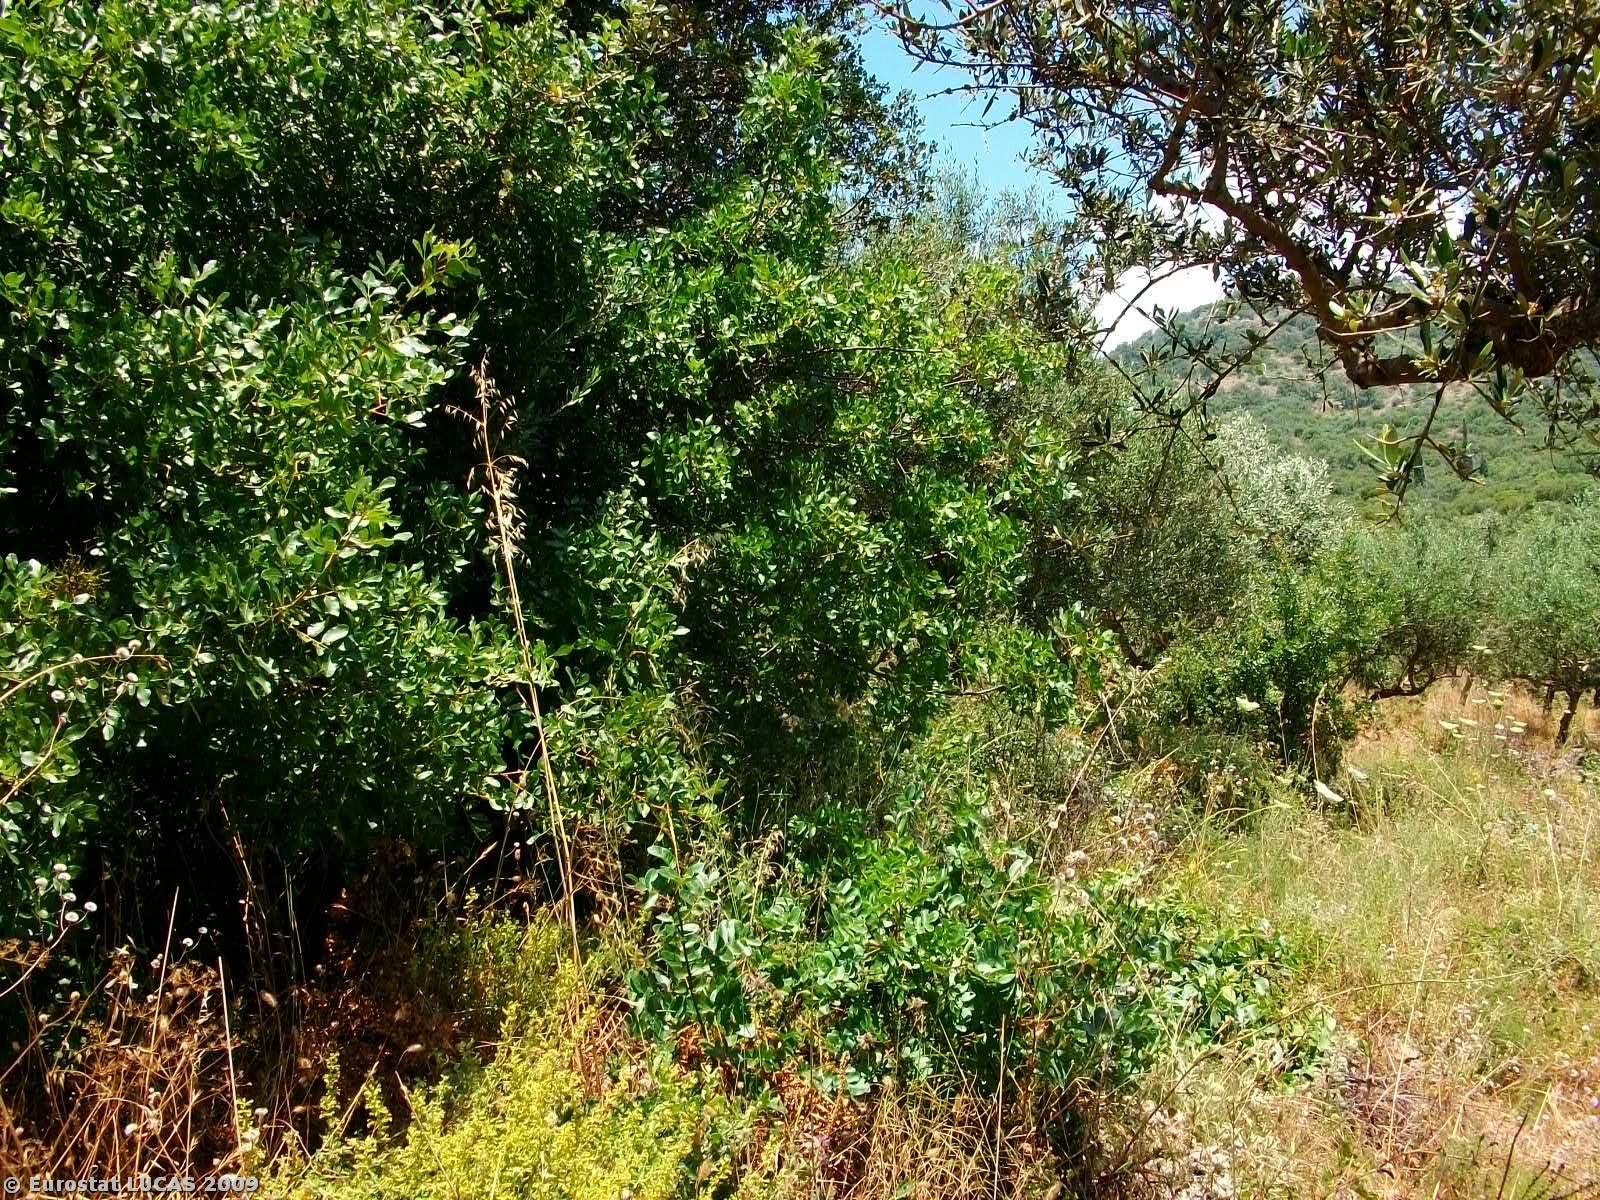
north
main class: Cropland
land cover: Olive groves
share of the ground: 50 - 75 %
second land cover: Grassland with sparse tree/shrub cover
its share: > 75 %
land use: Agriculture (excluding fallow land and kitchen gardens)
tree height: < 5 m
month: June
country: GR
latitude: 36.8570
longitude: 22.2783
